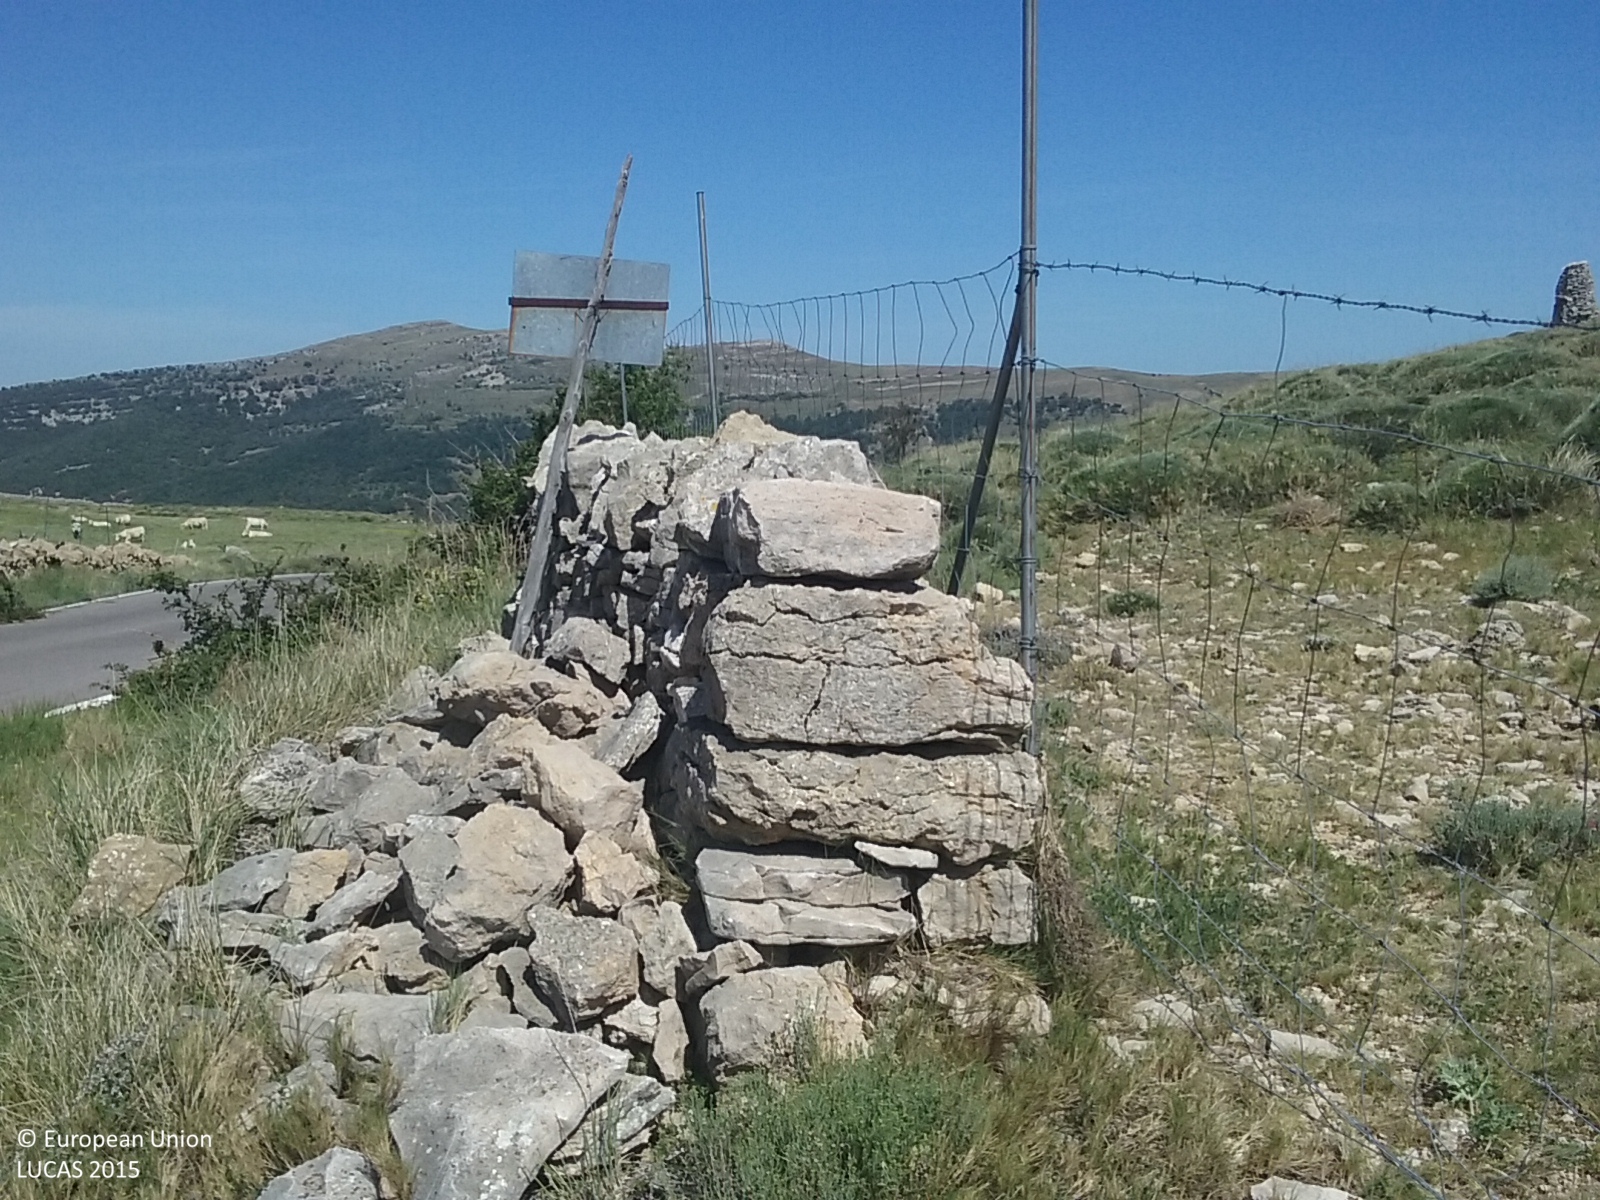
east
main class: Grassland
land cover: Grassland without tree/shrub cover
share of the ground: 25 - 50 %
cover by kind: herbaceous plants 20 %
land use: Abandoned areas
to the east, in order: Grassland without tree/shrub cover; Rock outcrops; Grassland without tree/shrub cover
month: May
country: ES
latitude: 40.4589
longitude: -0.0647
